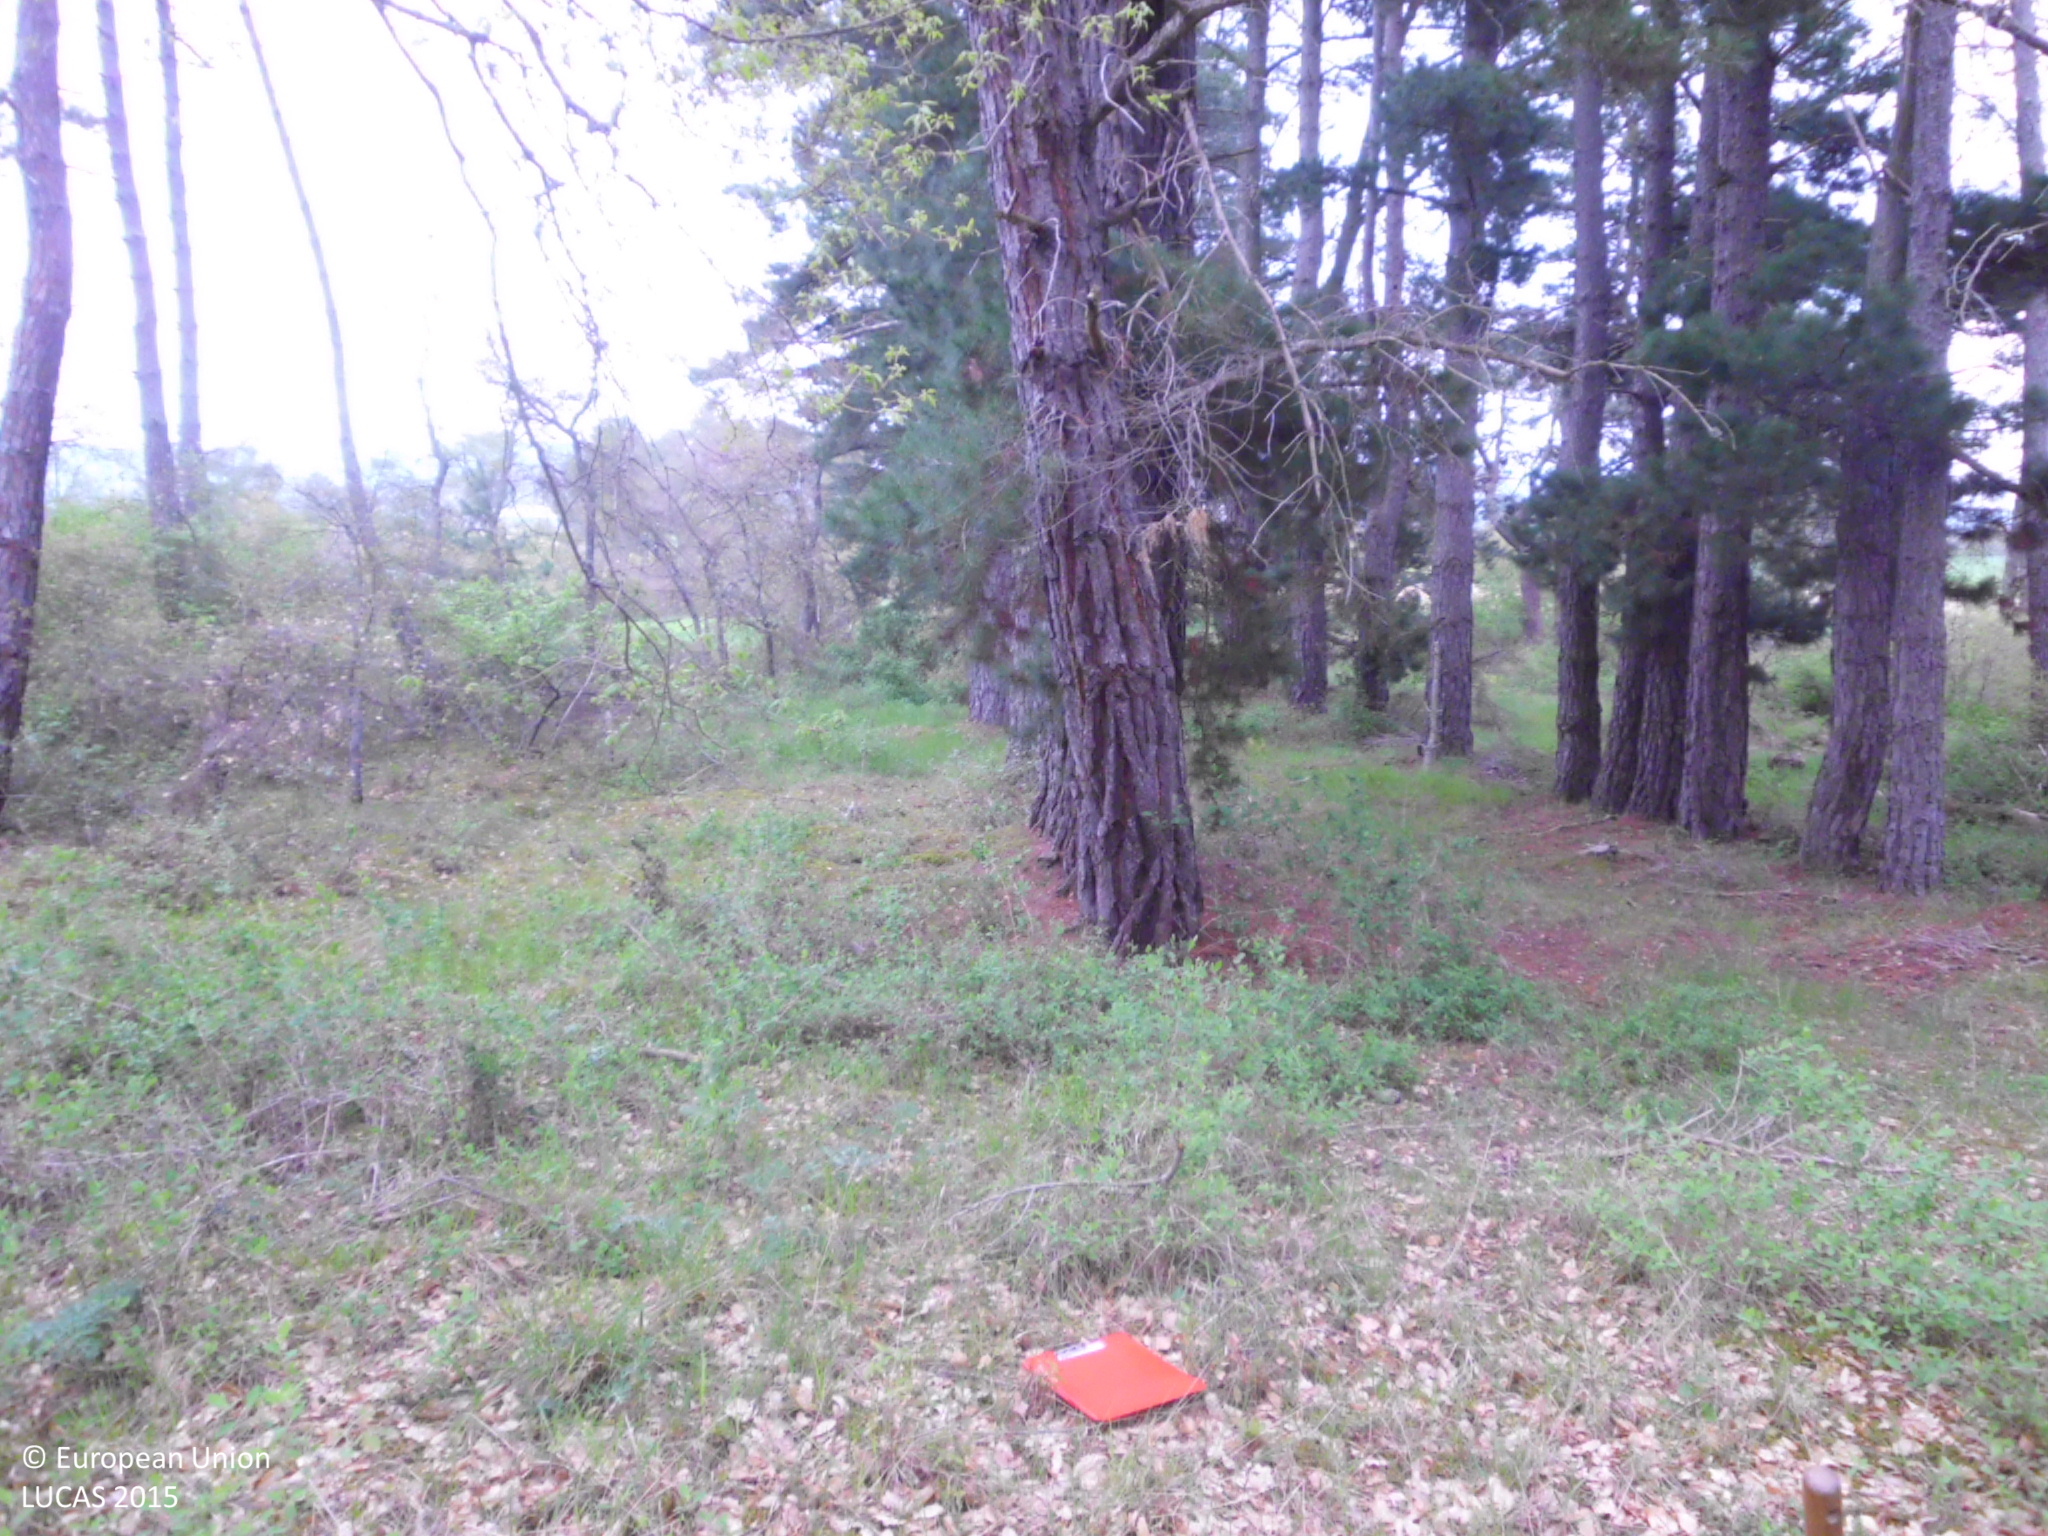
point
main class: Woodland
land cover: Pine dominated mixed woodland
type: coniferous forest of the mediterranean region
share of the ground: > 75 %
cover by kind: coniferous forest trees 50 %, broadleaved forest trees 25 %, shrubs 15 %, herbaceous plants 10 %
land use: Semi-natural and natural areas not in use
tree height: > 5 m
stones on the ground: < 10 %
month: April
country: ES
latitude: 42.8041
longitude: -3.3768
